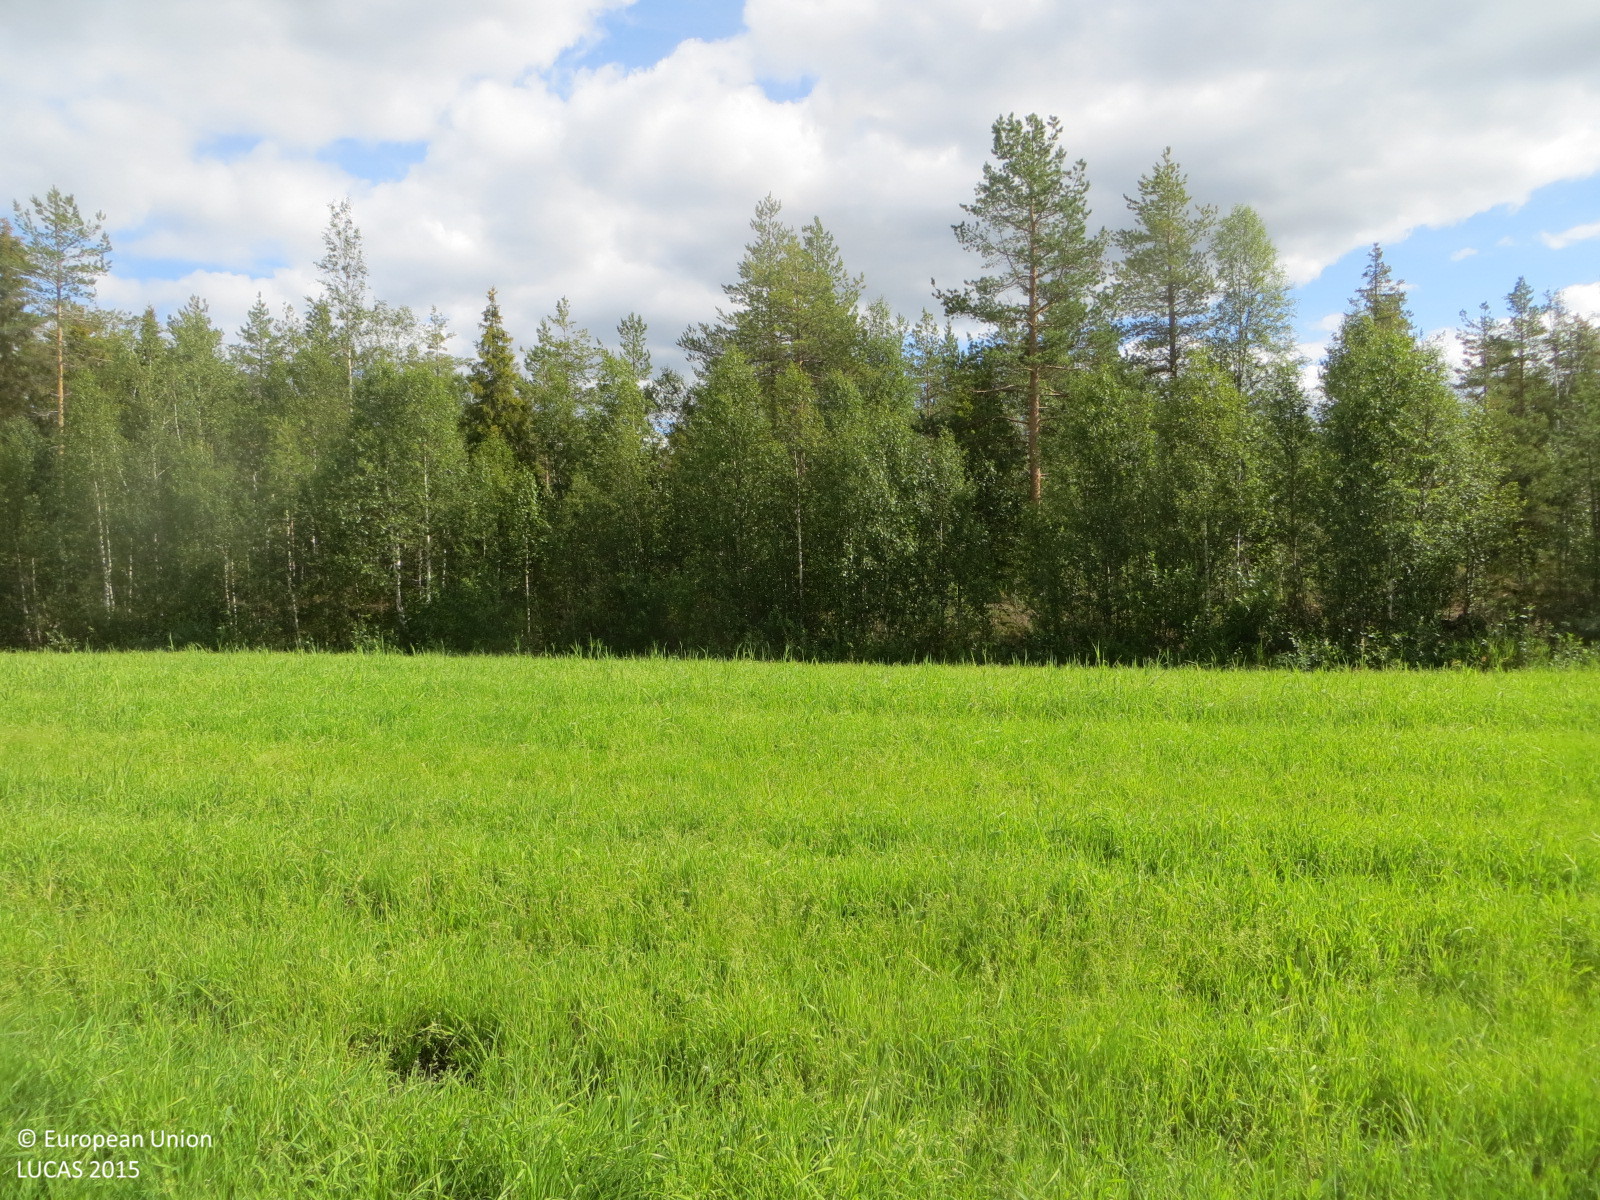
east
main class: Grassland
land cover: Grassland without tree/shrub cover
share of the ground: > 75 %
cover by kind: herbaceous plants 100 %
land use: Agriculture (excluding fallow land and kitchen gardens)
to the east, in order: Grassland without tree/shrub cover; Ditches and canals; Other mixed woodland; Ditches and canals; Other mixed woodland; Pine dominated mixed woodland; Ditches and canals; Other mixed woodland; Broadleaved woodland; Ditches and canals; Other mixed woodland; Ditches and canals; Pine dominated mixed woodland; Ditches and canals; Broadleaved woodland
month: August
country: FI
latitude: 66.2291
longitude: 25.6108
